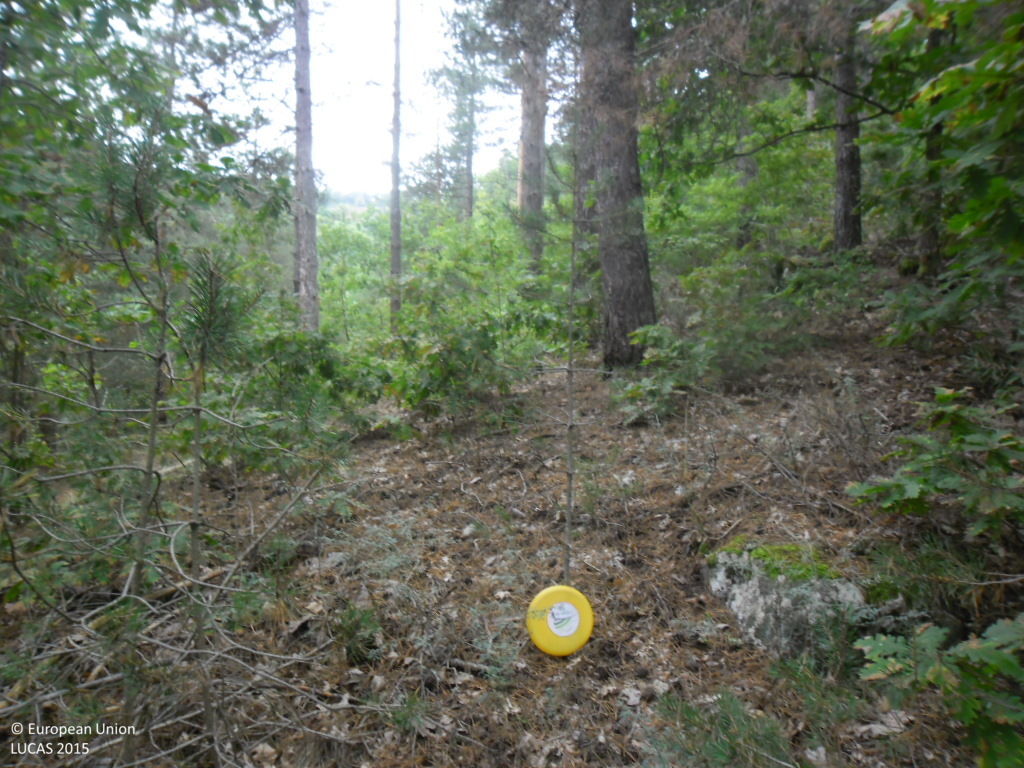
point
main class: Woodland
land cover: Pine dominated coniferous woodland
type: hemiboreal forest and nemoral coniferous forest and mixed broadleaved-coniferous forest
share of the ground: > 75 %
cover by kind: coniferous forest trees 95 %, unconsolidated bare surface 5 %
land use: Forestry
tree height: > 5 m
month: September
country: BG
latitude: 41.6418
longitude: 23.0458
